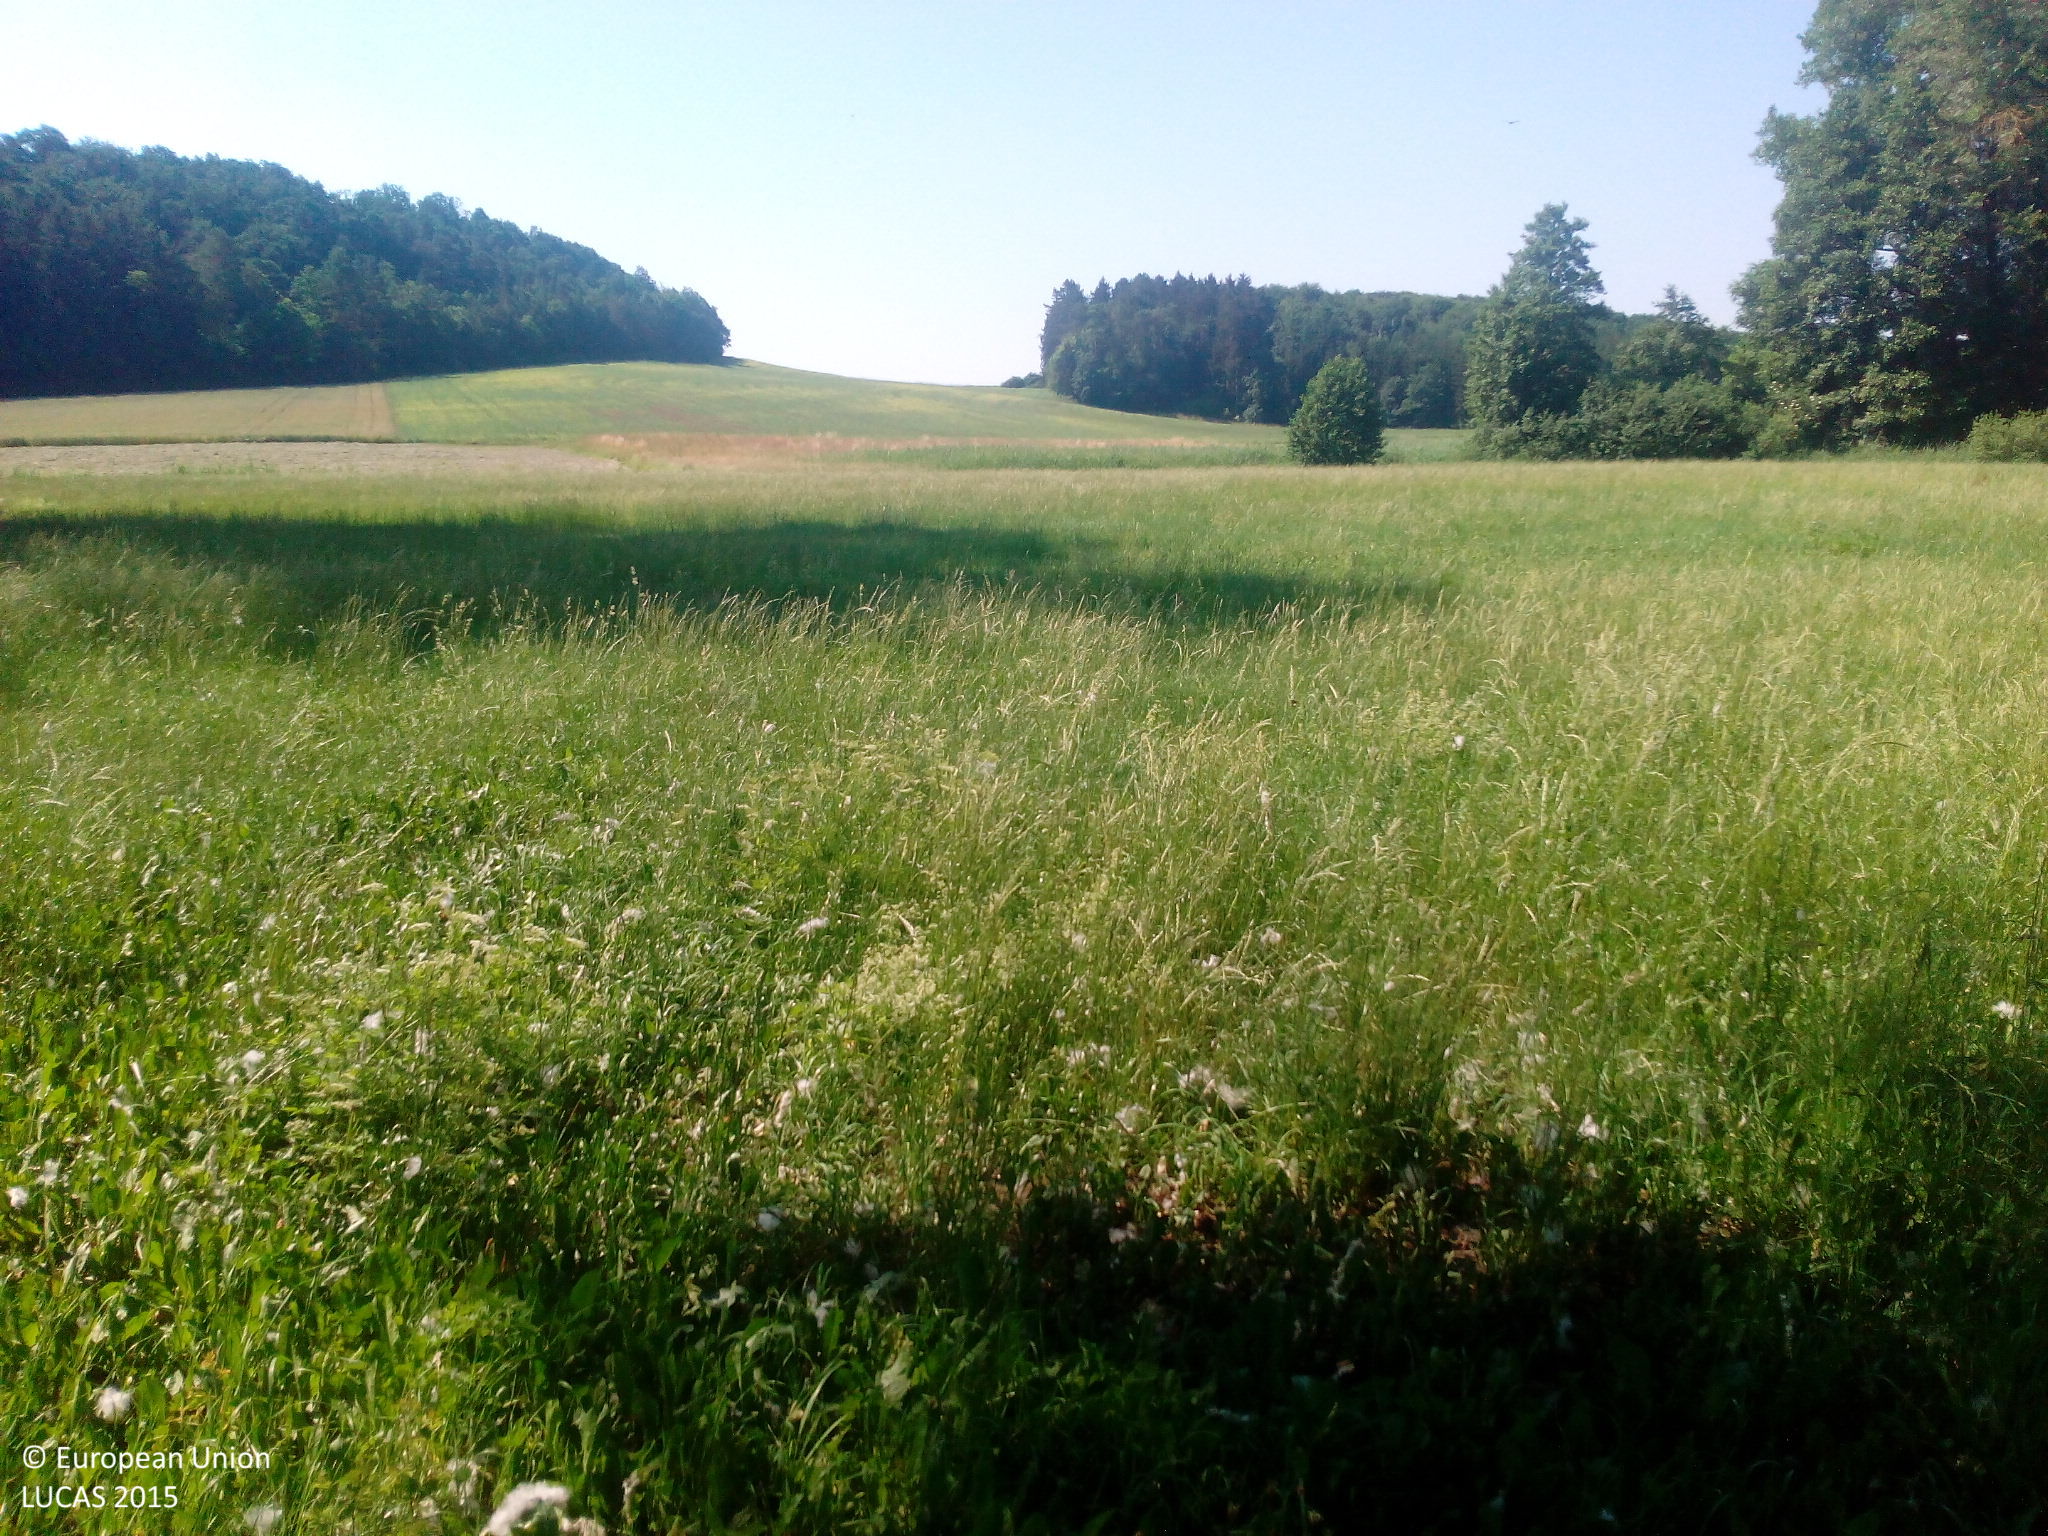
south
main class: Woodland
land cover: Broadleaved woodland
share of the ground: > 75 %
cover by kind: broadleaved forest trees 80 %, shrubs 20 %
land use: Semi-natural and natural areas not in use
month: July
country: DE
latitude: 50.2009
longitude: 10.5462
